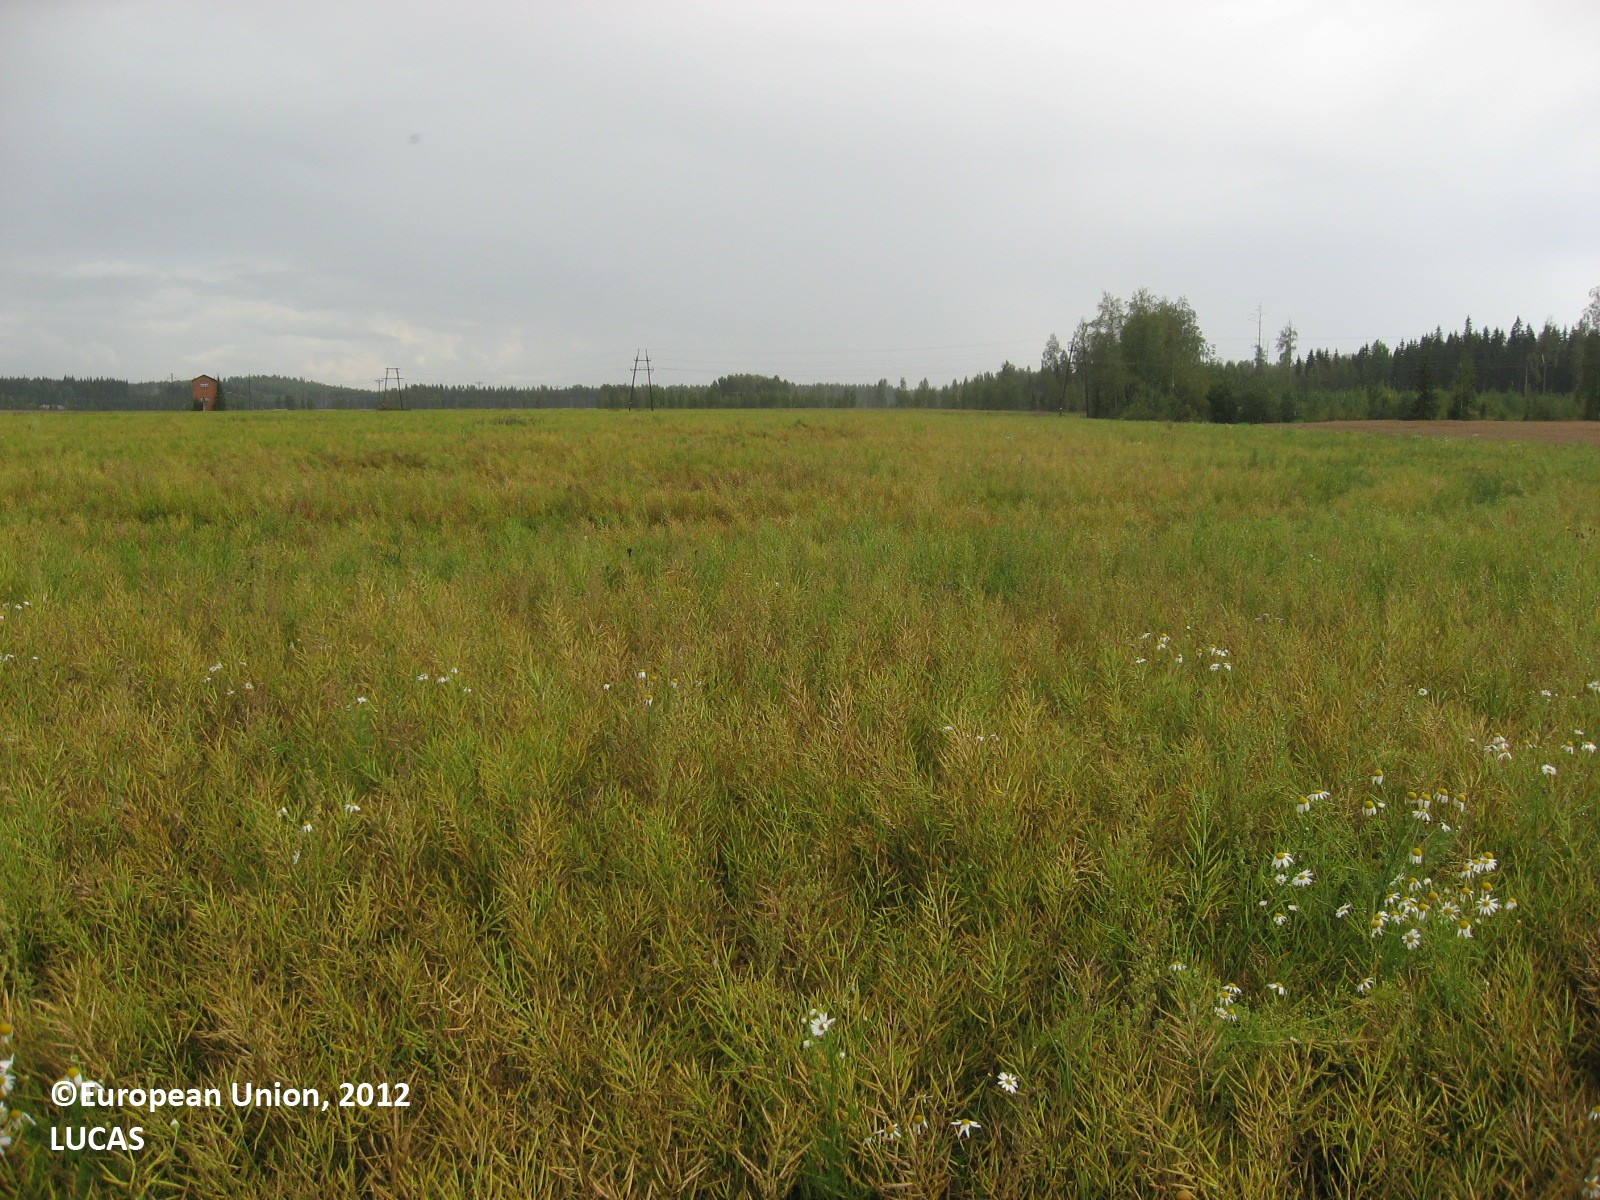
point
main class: Cropland
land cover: Rape and turnip rape
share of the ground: > 75 %
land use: Agriculture (excluding fallow land and kitchen gardens)
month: August
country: FI
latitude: 60.7570
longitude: 25.1107
